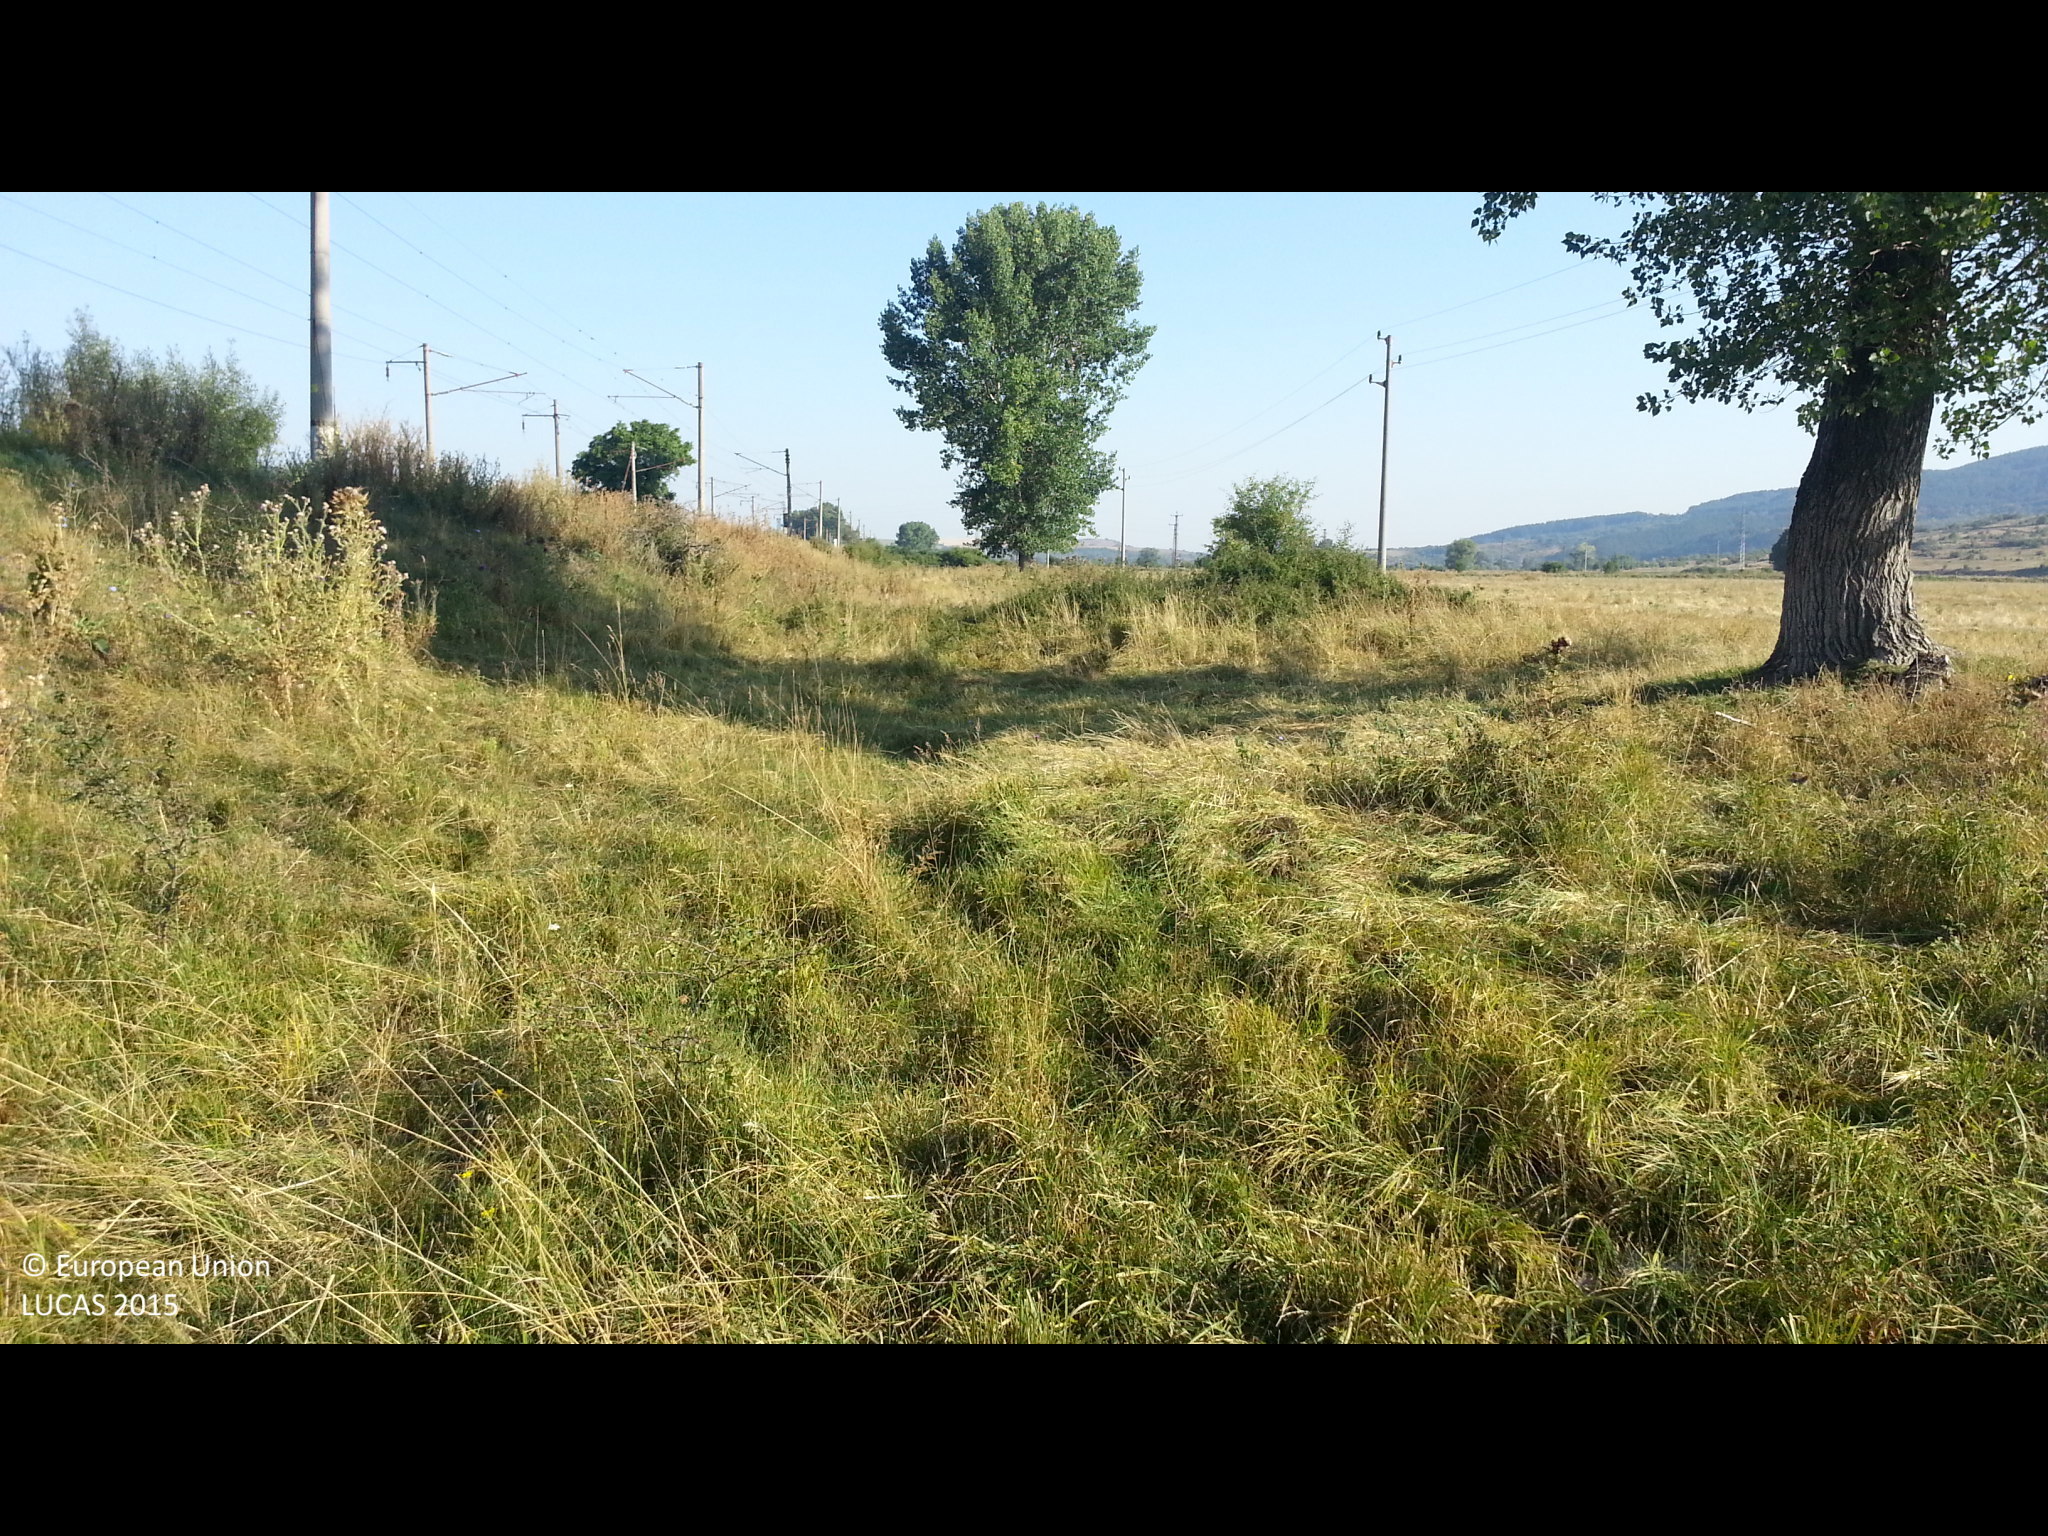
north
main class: Grassland
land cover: Grassland with sparse tree/shrub cover
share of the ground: > 75 %
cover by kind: herbaceous plants 95 %, broadleaved forest trees 5 %
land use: Agriculture (excluding fallow land and kitchen gardens)
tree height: > 5 m
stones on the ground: < 10 %
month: August
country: BG
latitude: 42.5496
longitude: 22.9487
